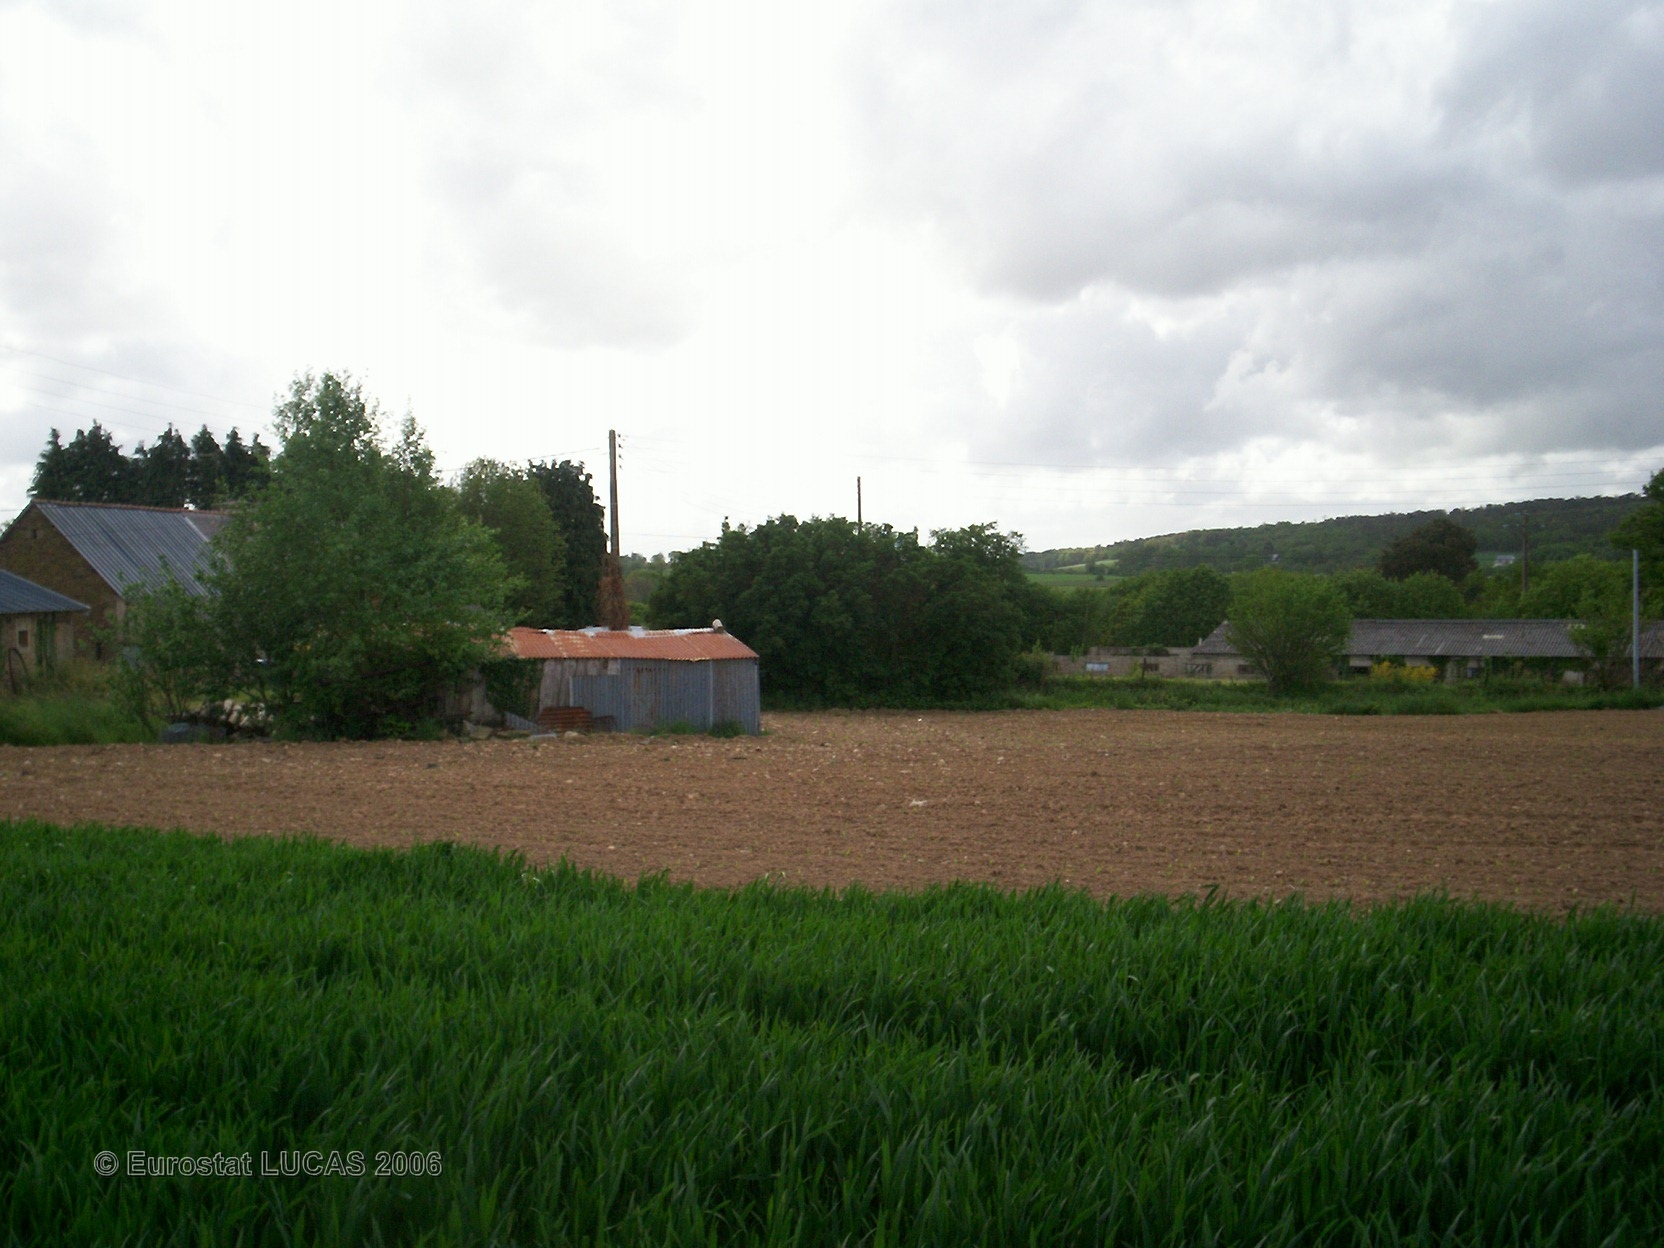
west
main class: Cropland
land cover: Common wheat
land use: Agriculture (excluding fallow land and kitchen gardens)
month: May
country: FR
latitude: 47.9008
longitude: -2.7308
